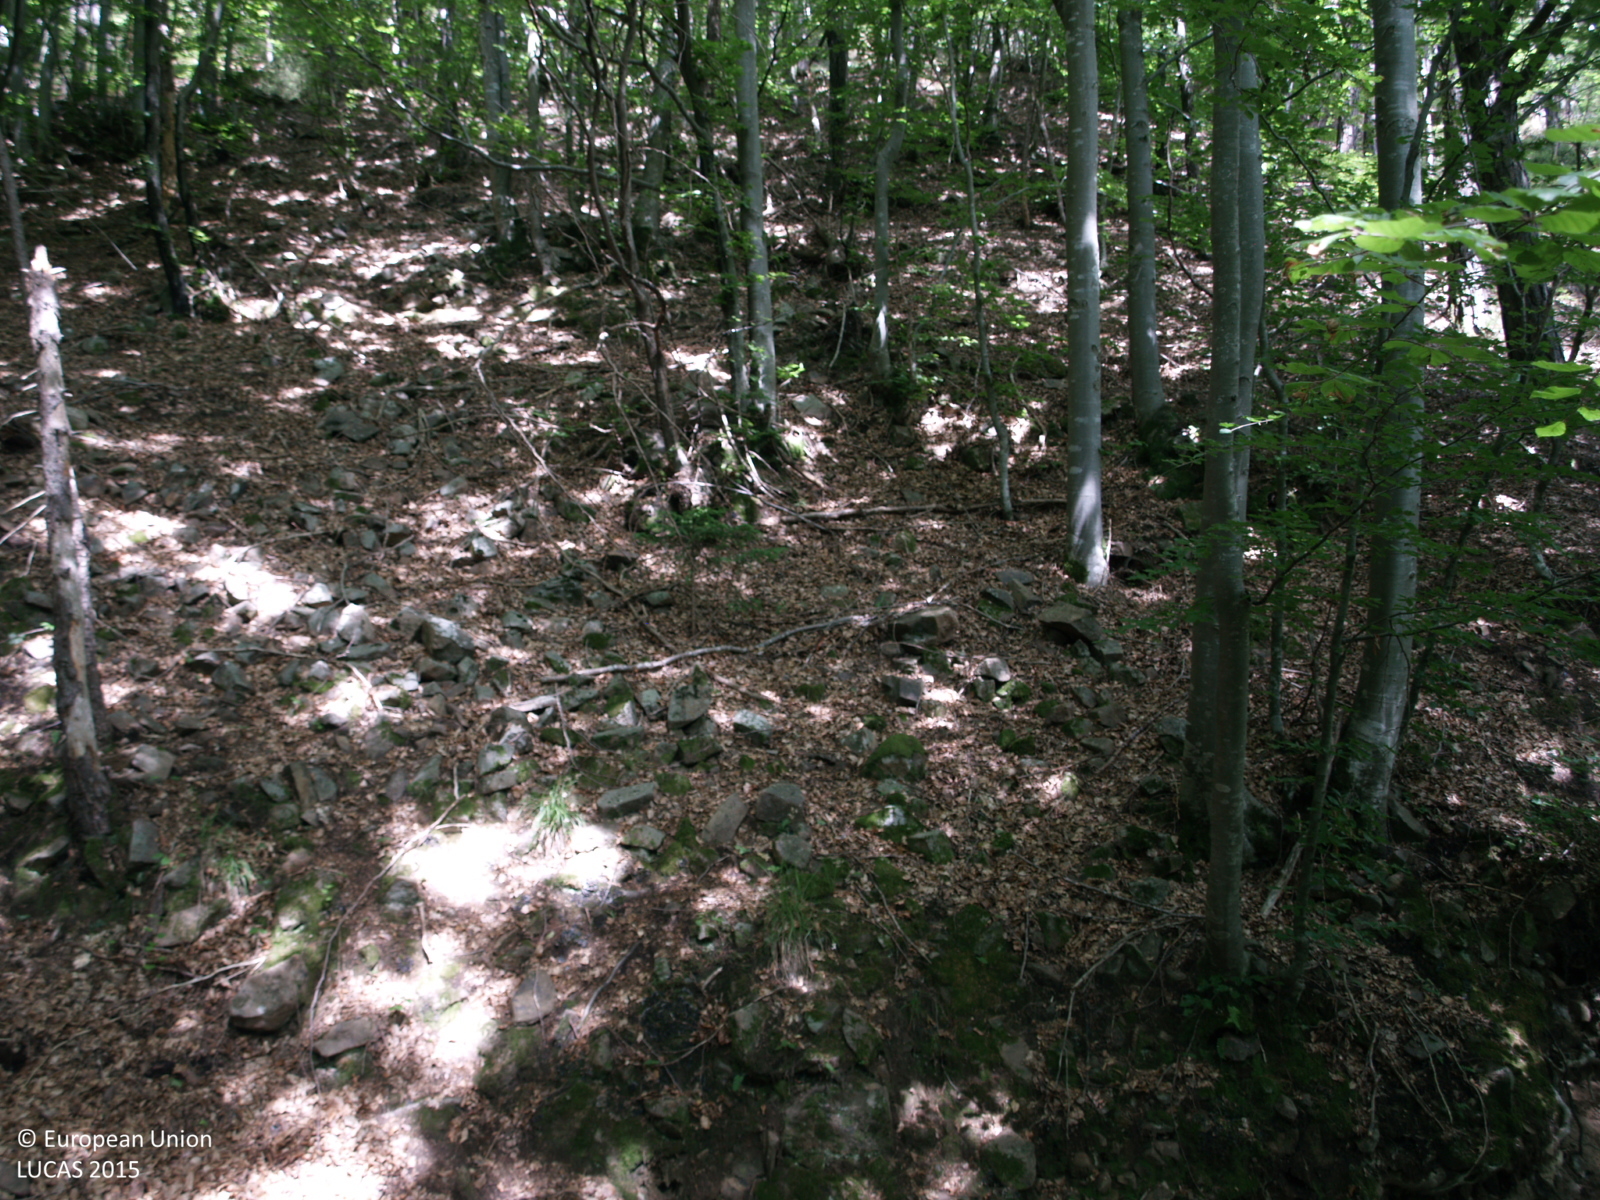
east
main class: Woodland
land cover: Other mixed woodland
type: alpine coniferous forest
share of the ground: > 75 %
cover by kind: coniferous forest trees 50 %, broadleaved forest trees 50 %
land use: Forestry
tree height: > 5 m
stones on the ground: < 10 %
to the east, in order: Other mixed woodland; Tracks; Other mixed woodland
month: May
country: IT
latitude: 45.8784
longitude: 10.9649
